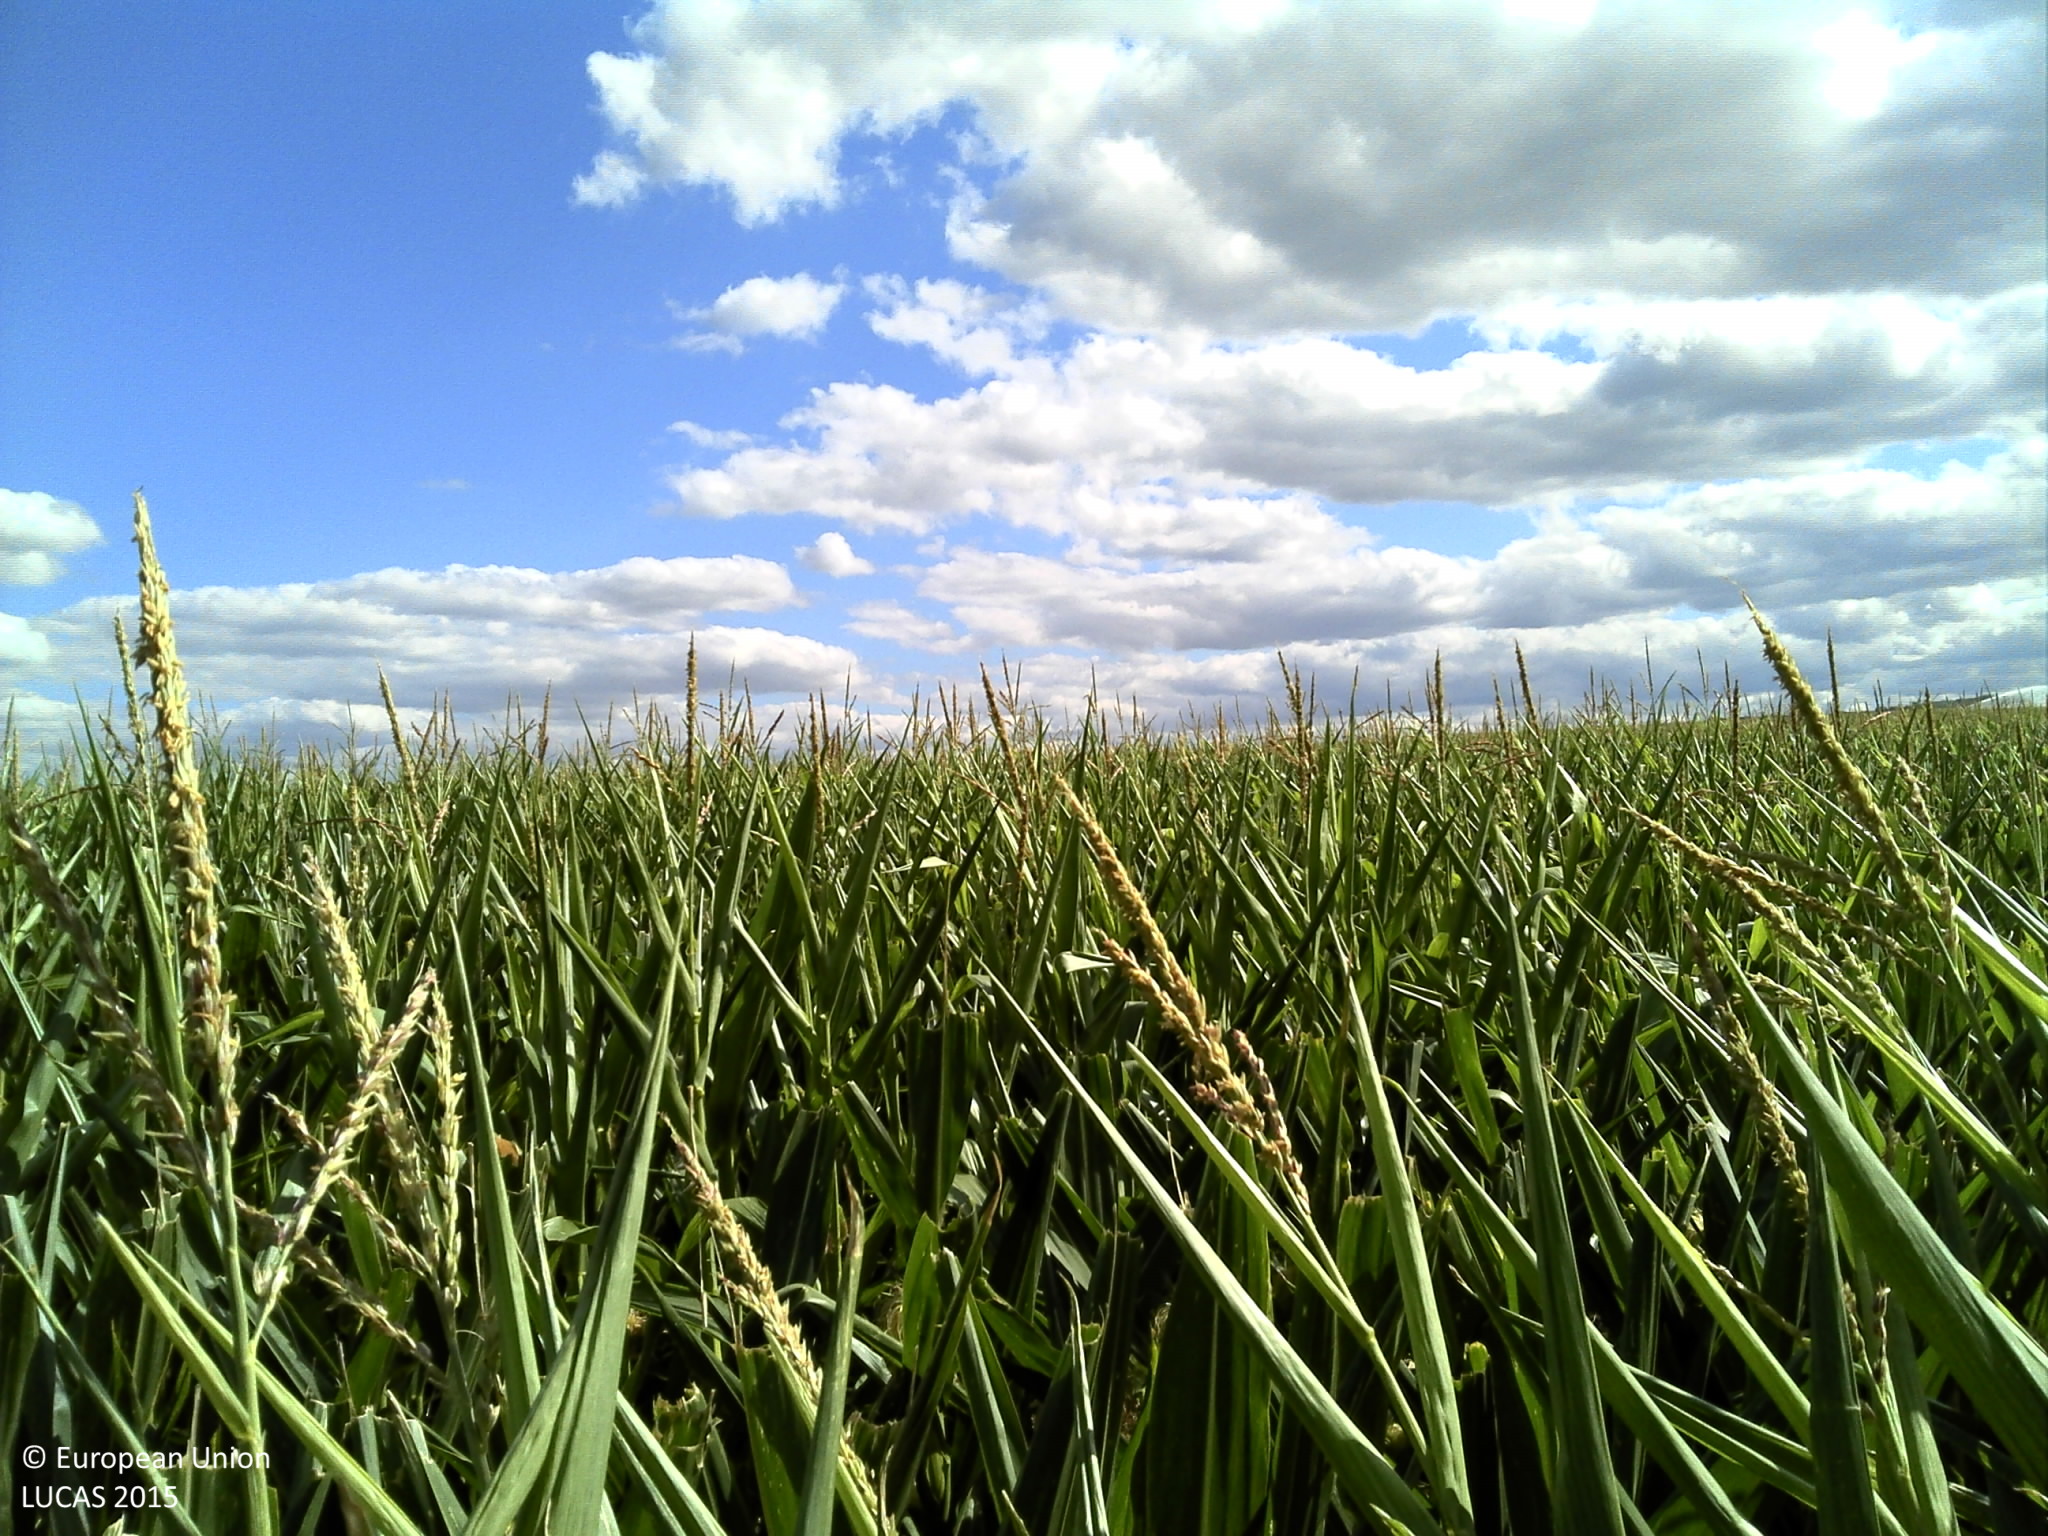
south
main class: Cropland
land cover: Maize
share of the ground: > 75 %
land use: Agriculture (excluding fallow land and kitchen gardens)
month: July
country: FR
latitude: 45.6083
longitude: 3.1662
